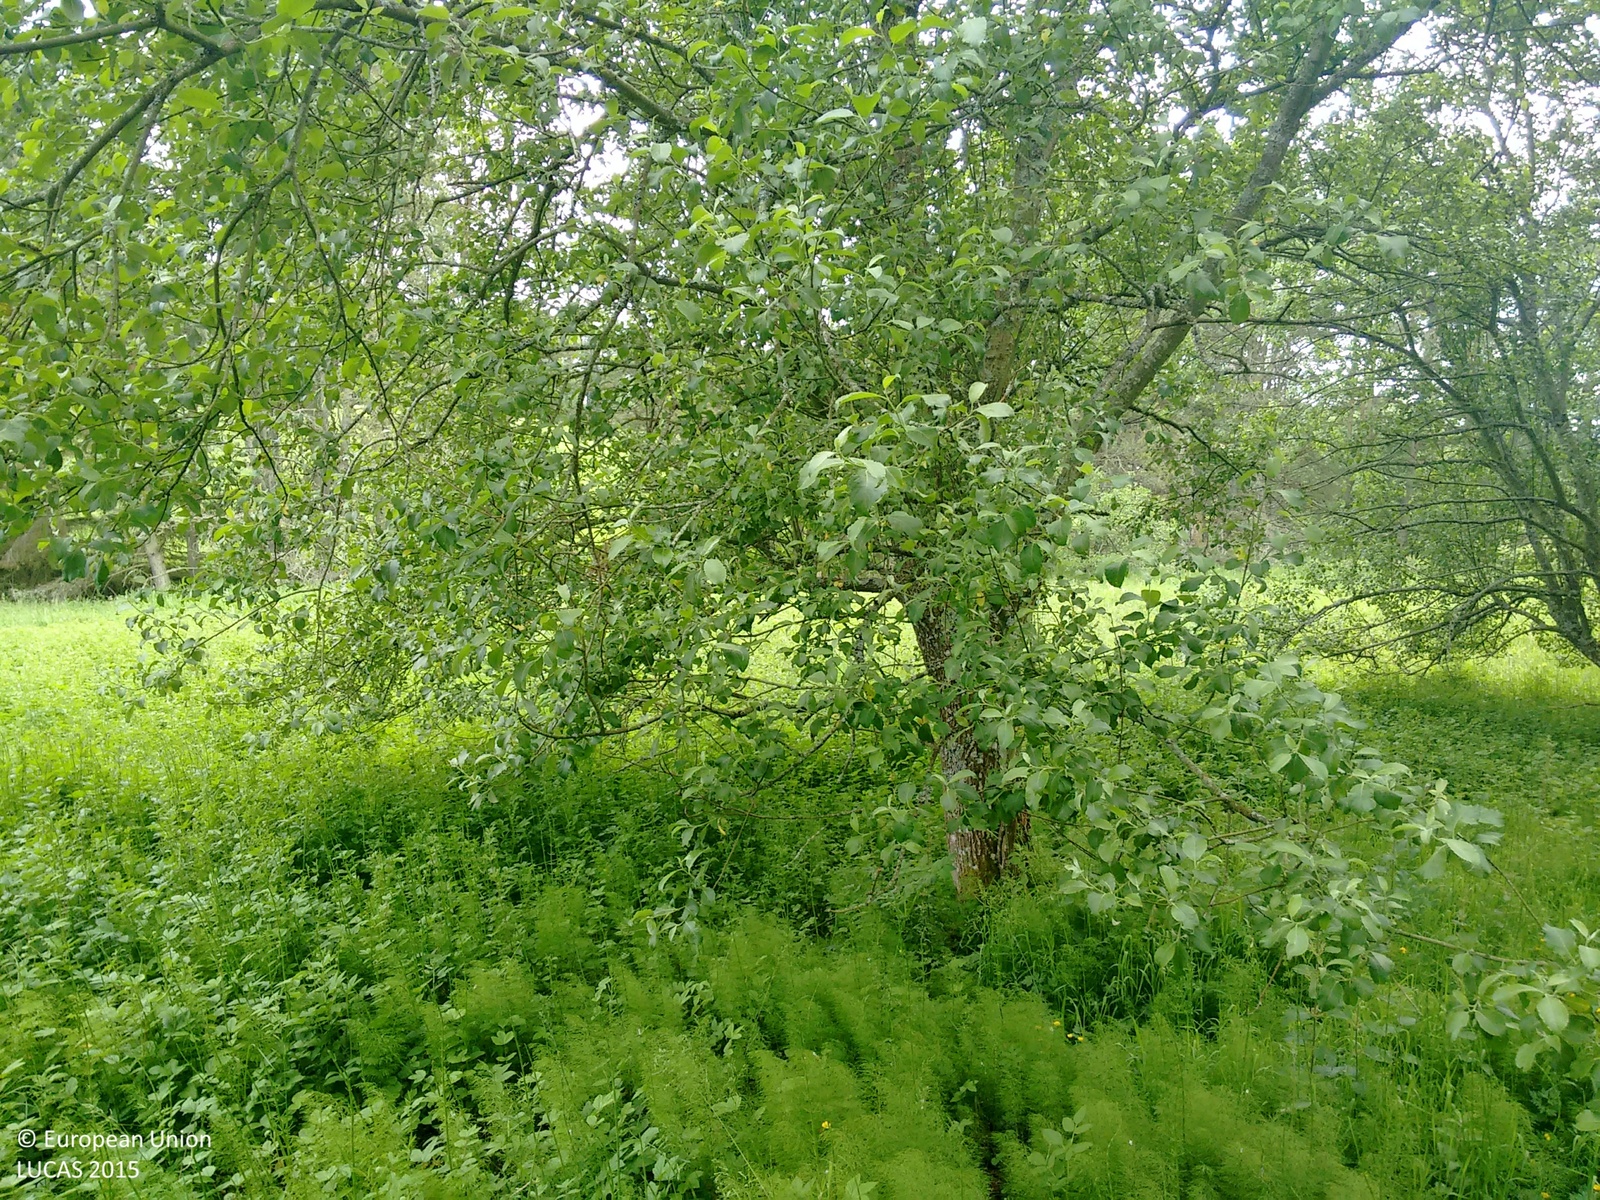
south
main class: Woodland
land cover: Broadleaved woodland
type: exotic forest
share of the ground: > 75 %
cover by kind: broadleaved forest trees 75 %, herbaceous plants 25 %
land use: Semi-natural and natural areas not in use
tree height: > 5 m
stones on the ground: < 10 %
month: June
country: GB
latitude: 57.1750
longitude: -2.7112
